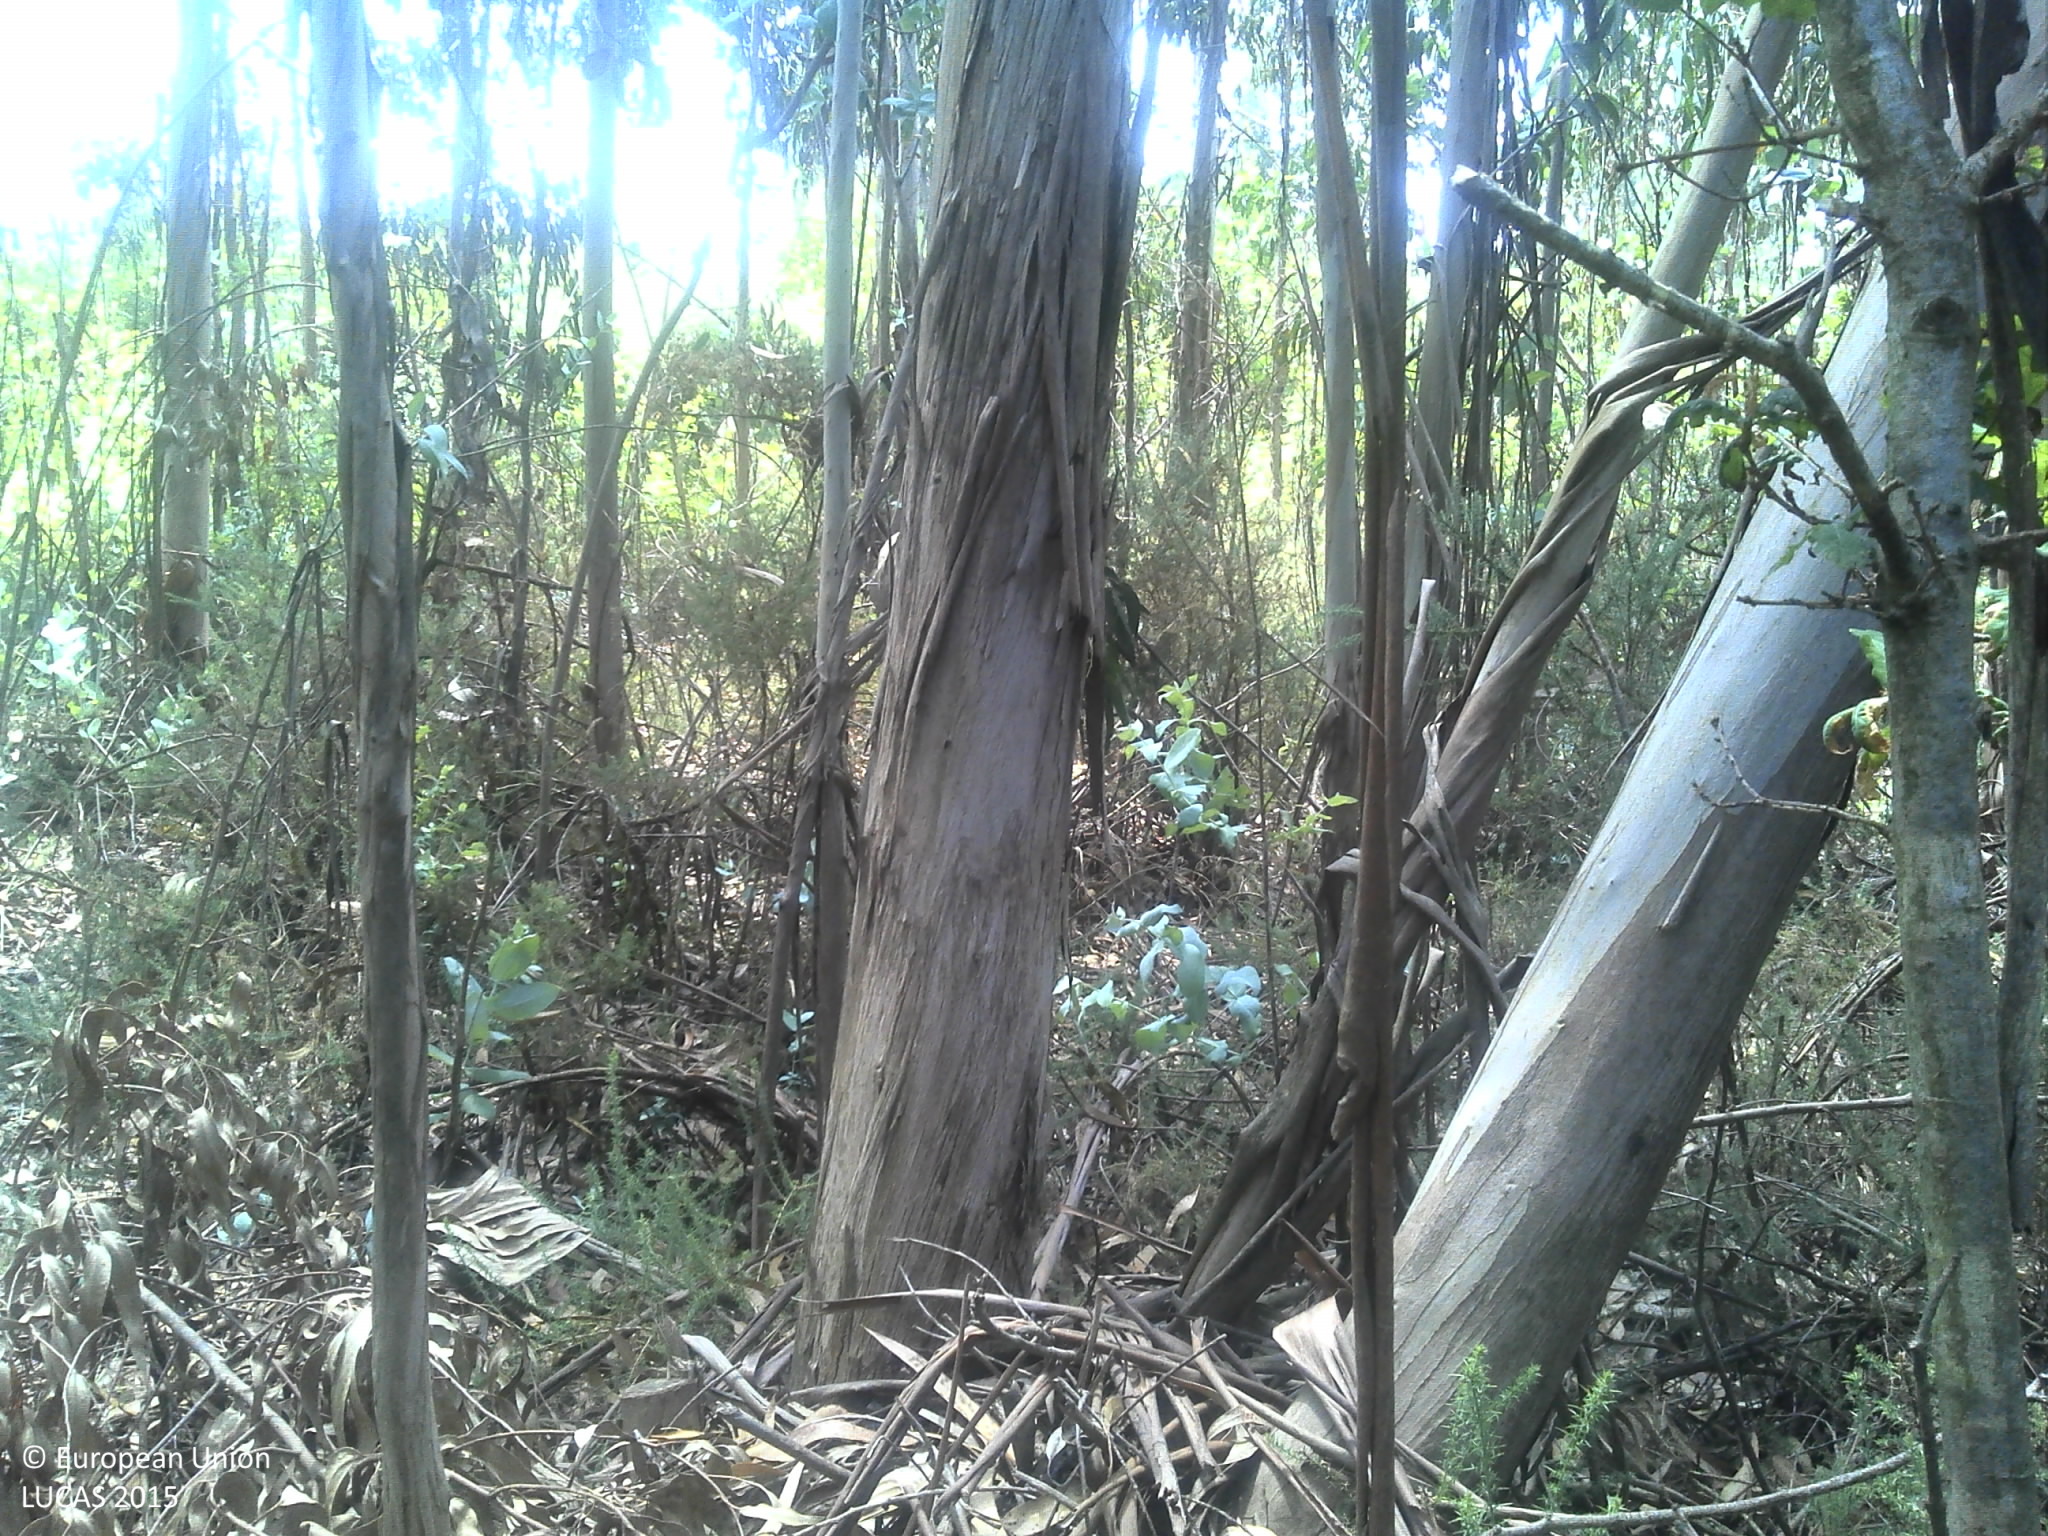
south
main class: Woodland
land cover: Broadleaved woodland
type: exotic forest
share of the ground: 50 - 75 %
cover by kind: broadleaved forest trees 70 %, shrubs 25 %, unconsolidated bare surface 5 %
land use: Forestry
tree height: > 5 m
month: June
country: PT
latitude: 41.4793
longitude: -8.5387
